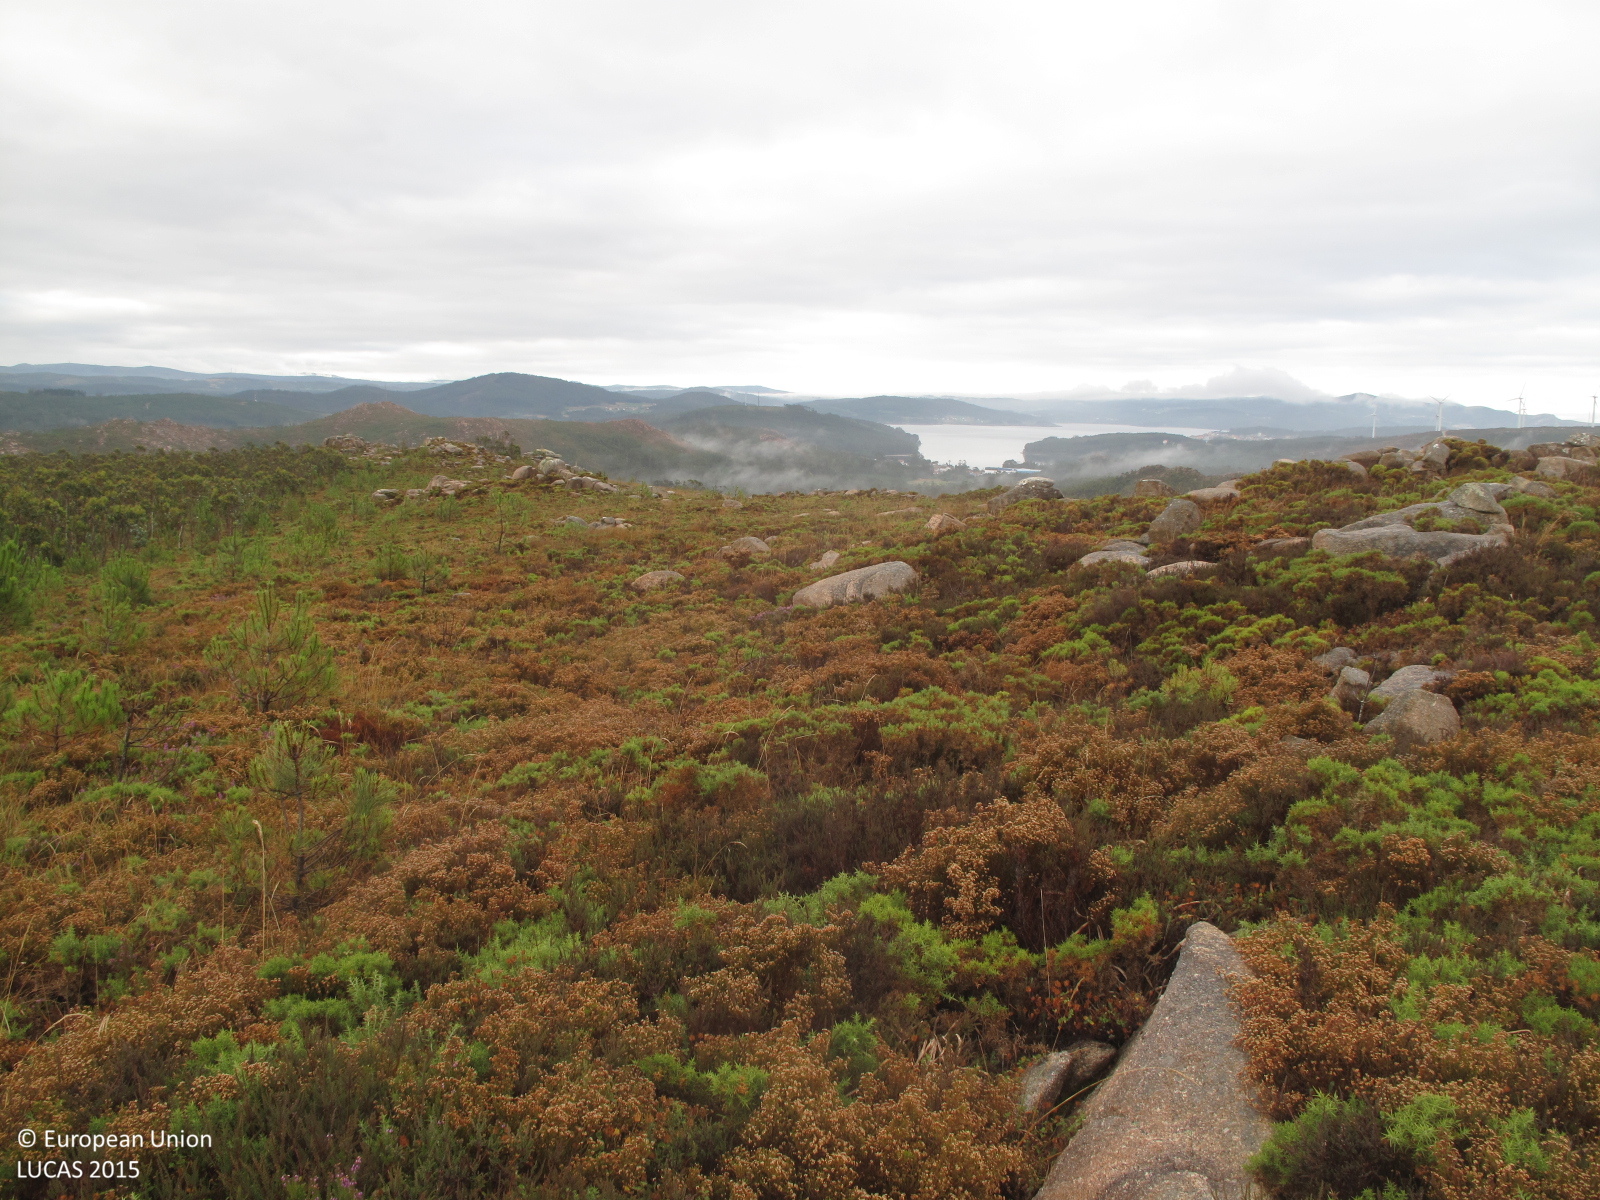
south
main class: Woodland
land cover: Pine dominated coniferous woodland
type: exotic forest
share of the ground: 10 - 25 %
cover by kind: shrubs 70 %, coniferous forest trees 20 %, consolidated bare surface 10 %
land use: Forestry
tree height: < 5 m
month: July
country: ES
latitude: 43.1735
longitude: -9.1592
